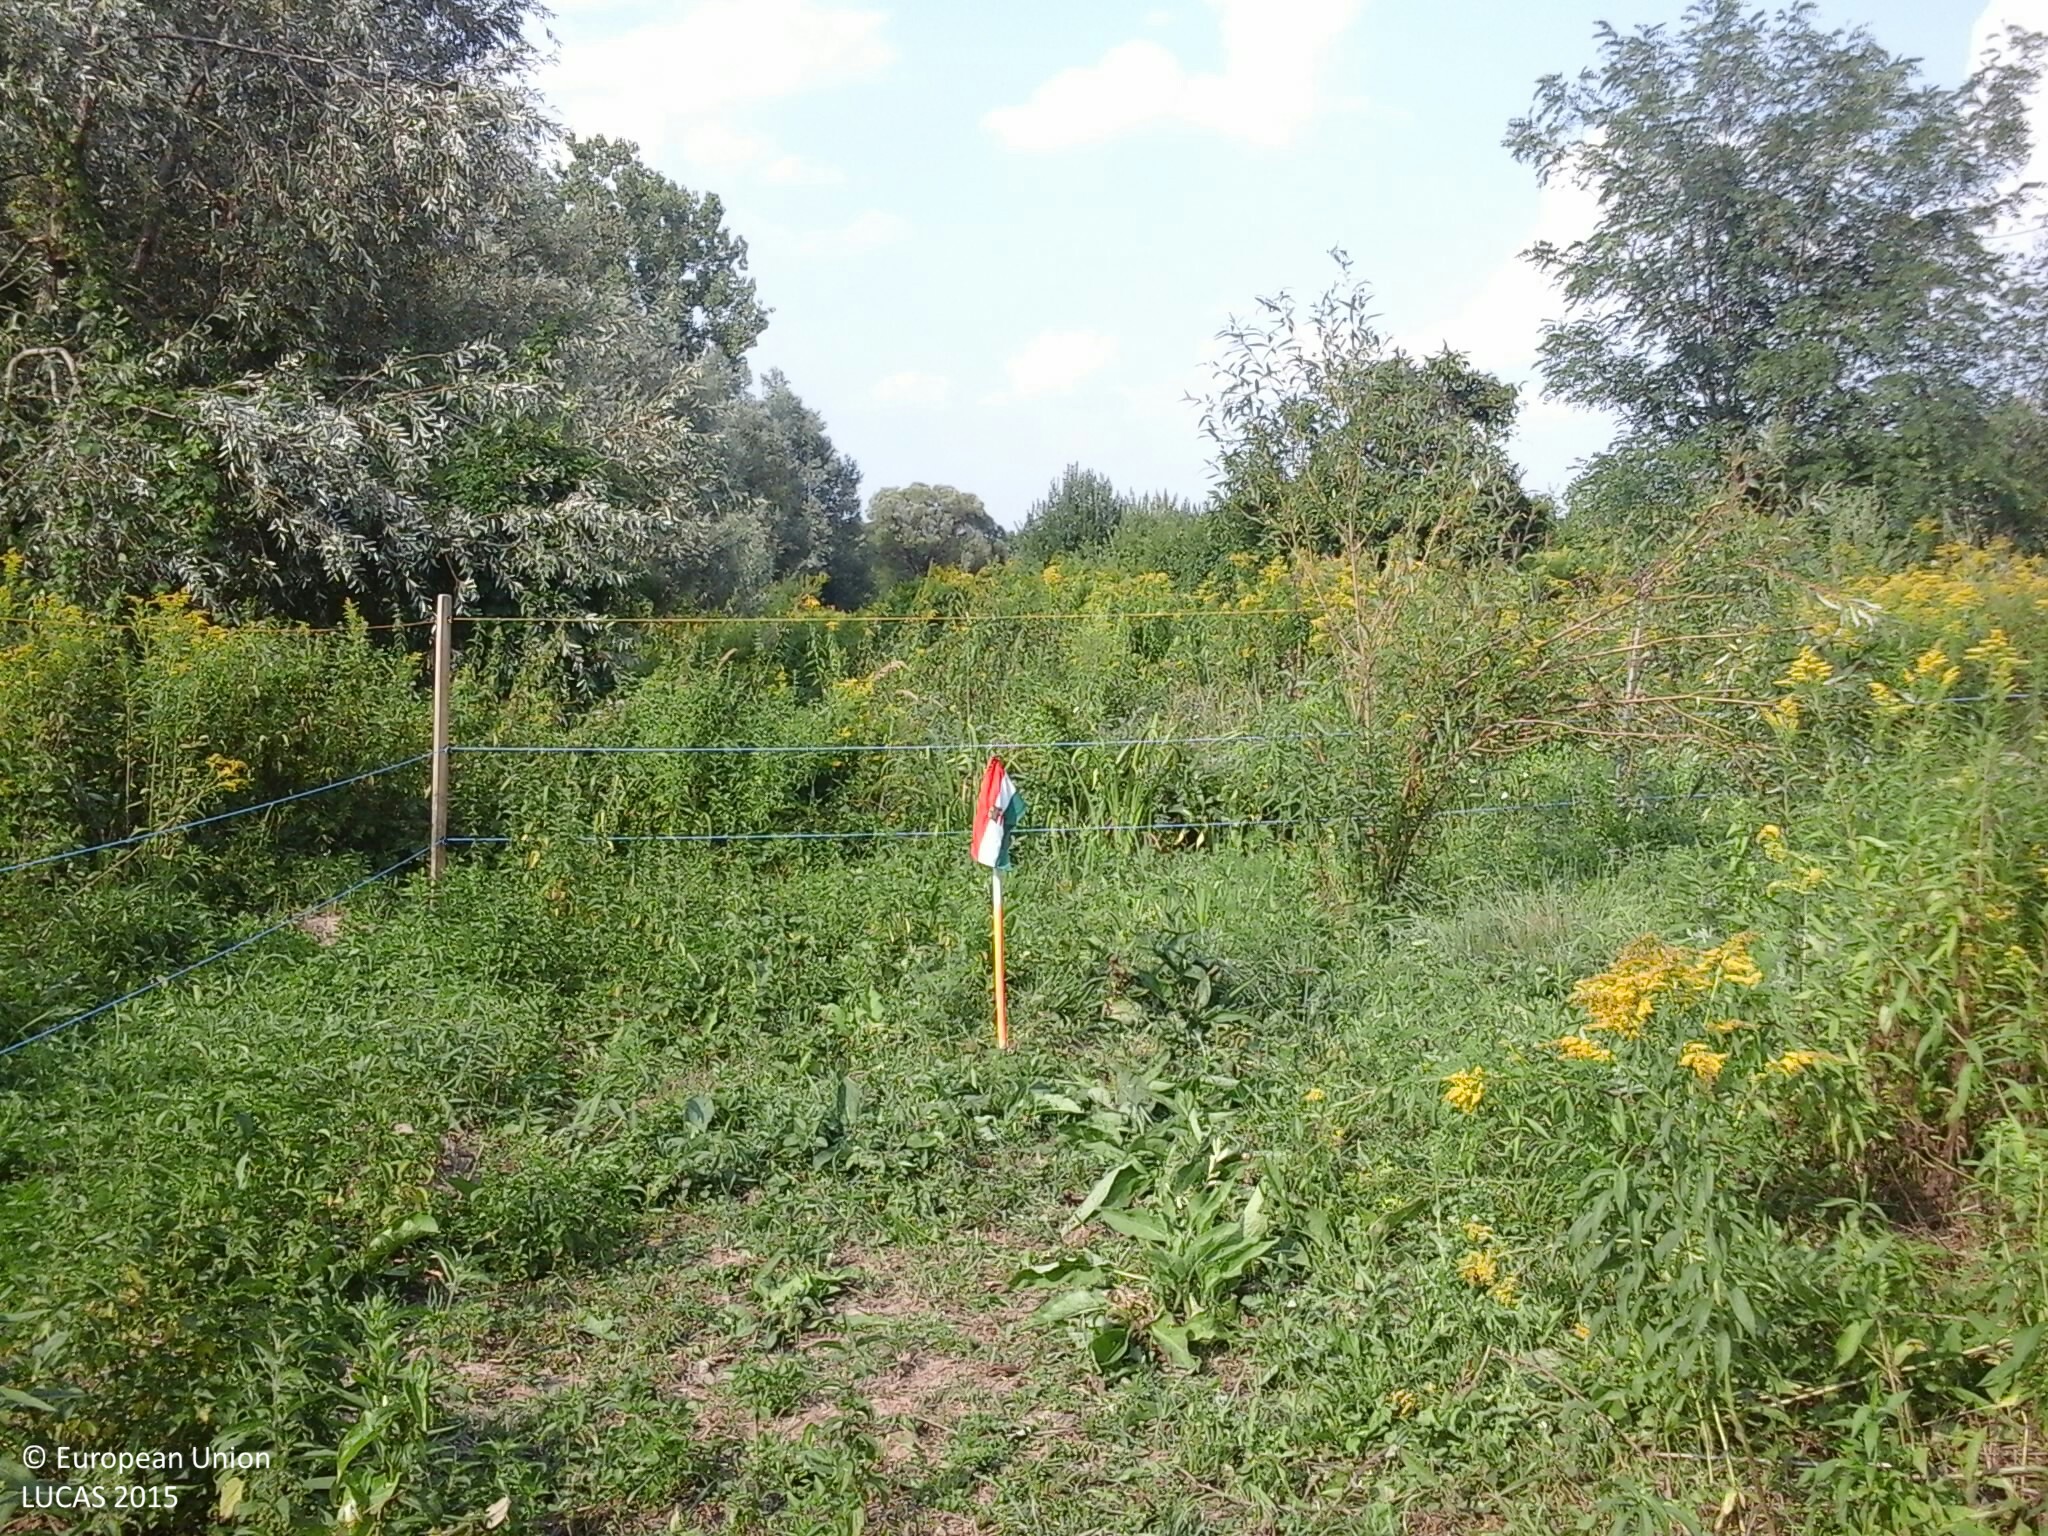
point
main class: Grassland
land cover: Spontaneously vegetated surfaces
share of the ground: > 75 %
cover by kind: herbaceous plants 100 %
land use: Fallow land
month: August
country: HU
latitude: 45.9377
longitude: 18.3004
